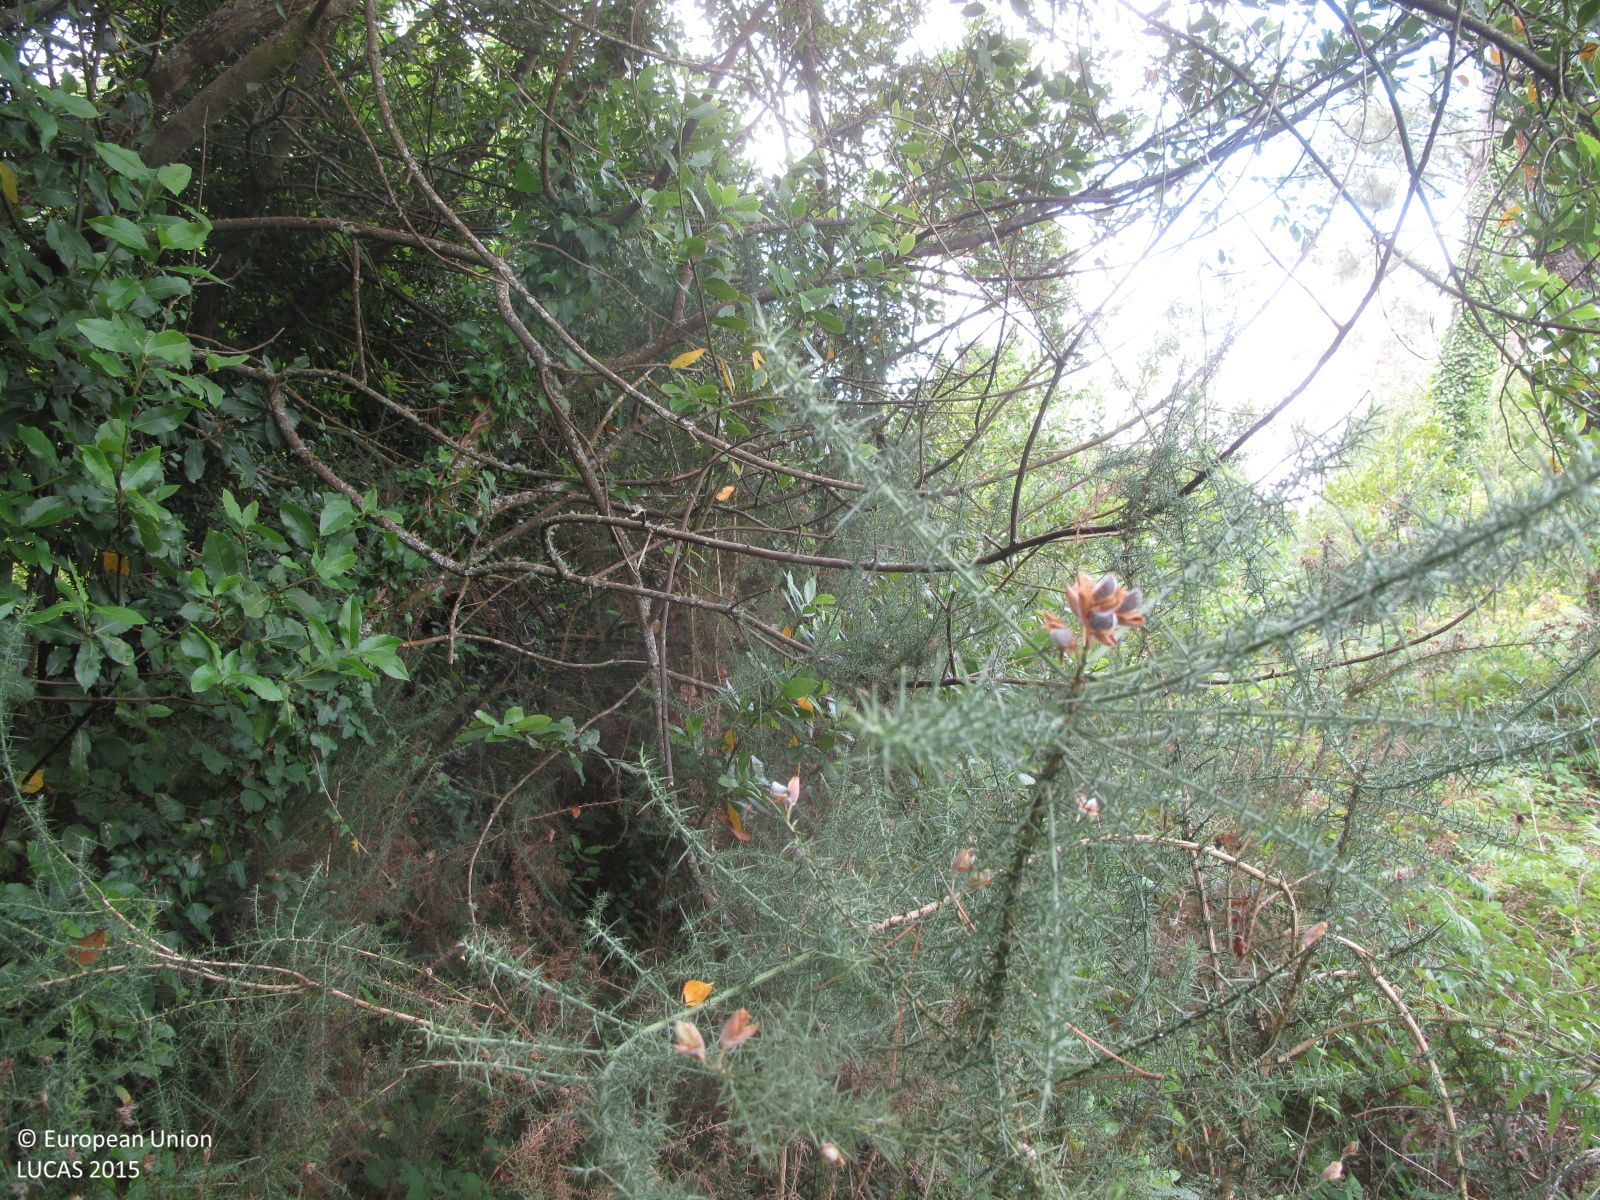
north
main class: Woodland
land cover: Broadleaved woodland
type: exotic forest
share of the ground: 25 - 50 %
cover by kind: shrubs 60 %, broadleaved forest trees 30 %, herbaceous plants 10 %
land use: Forestry
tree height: < 5 m
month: July
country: ES
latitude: 43.5173
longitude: -7.9971
